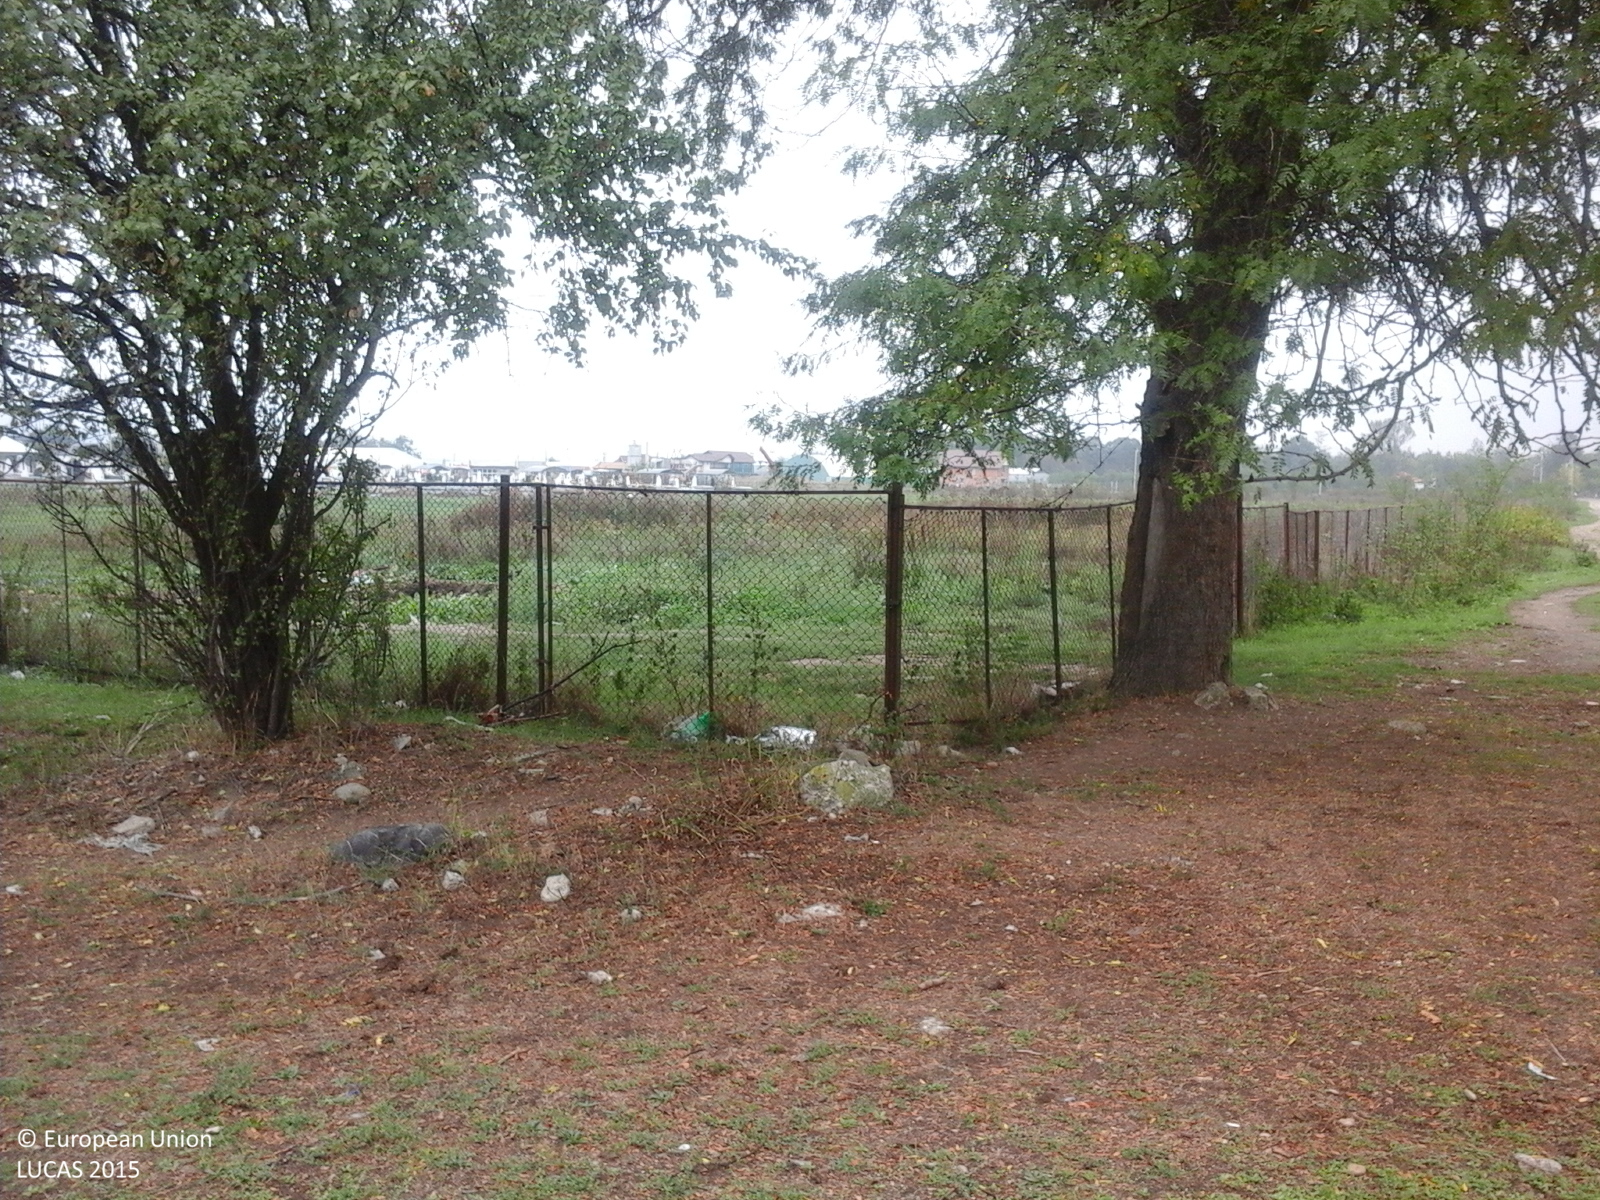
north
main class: Grassland
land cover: Grassland without tree/shrub cover
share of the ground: > 75 %
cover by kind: herbaceous plants 100 %
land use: Agriculture (excluding fallow land and kitchen gardens)
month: September
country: RO
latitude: 45.0424
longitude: 23.2954
